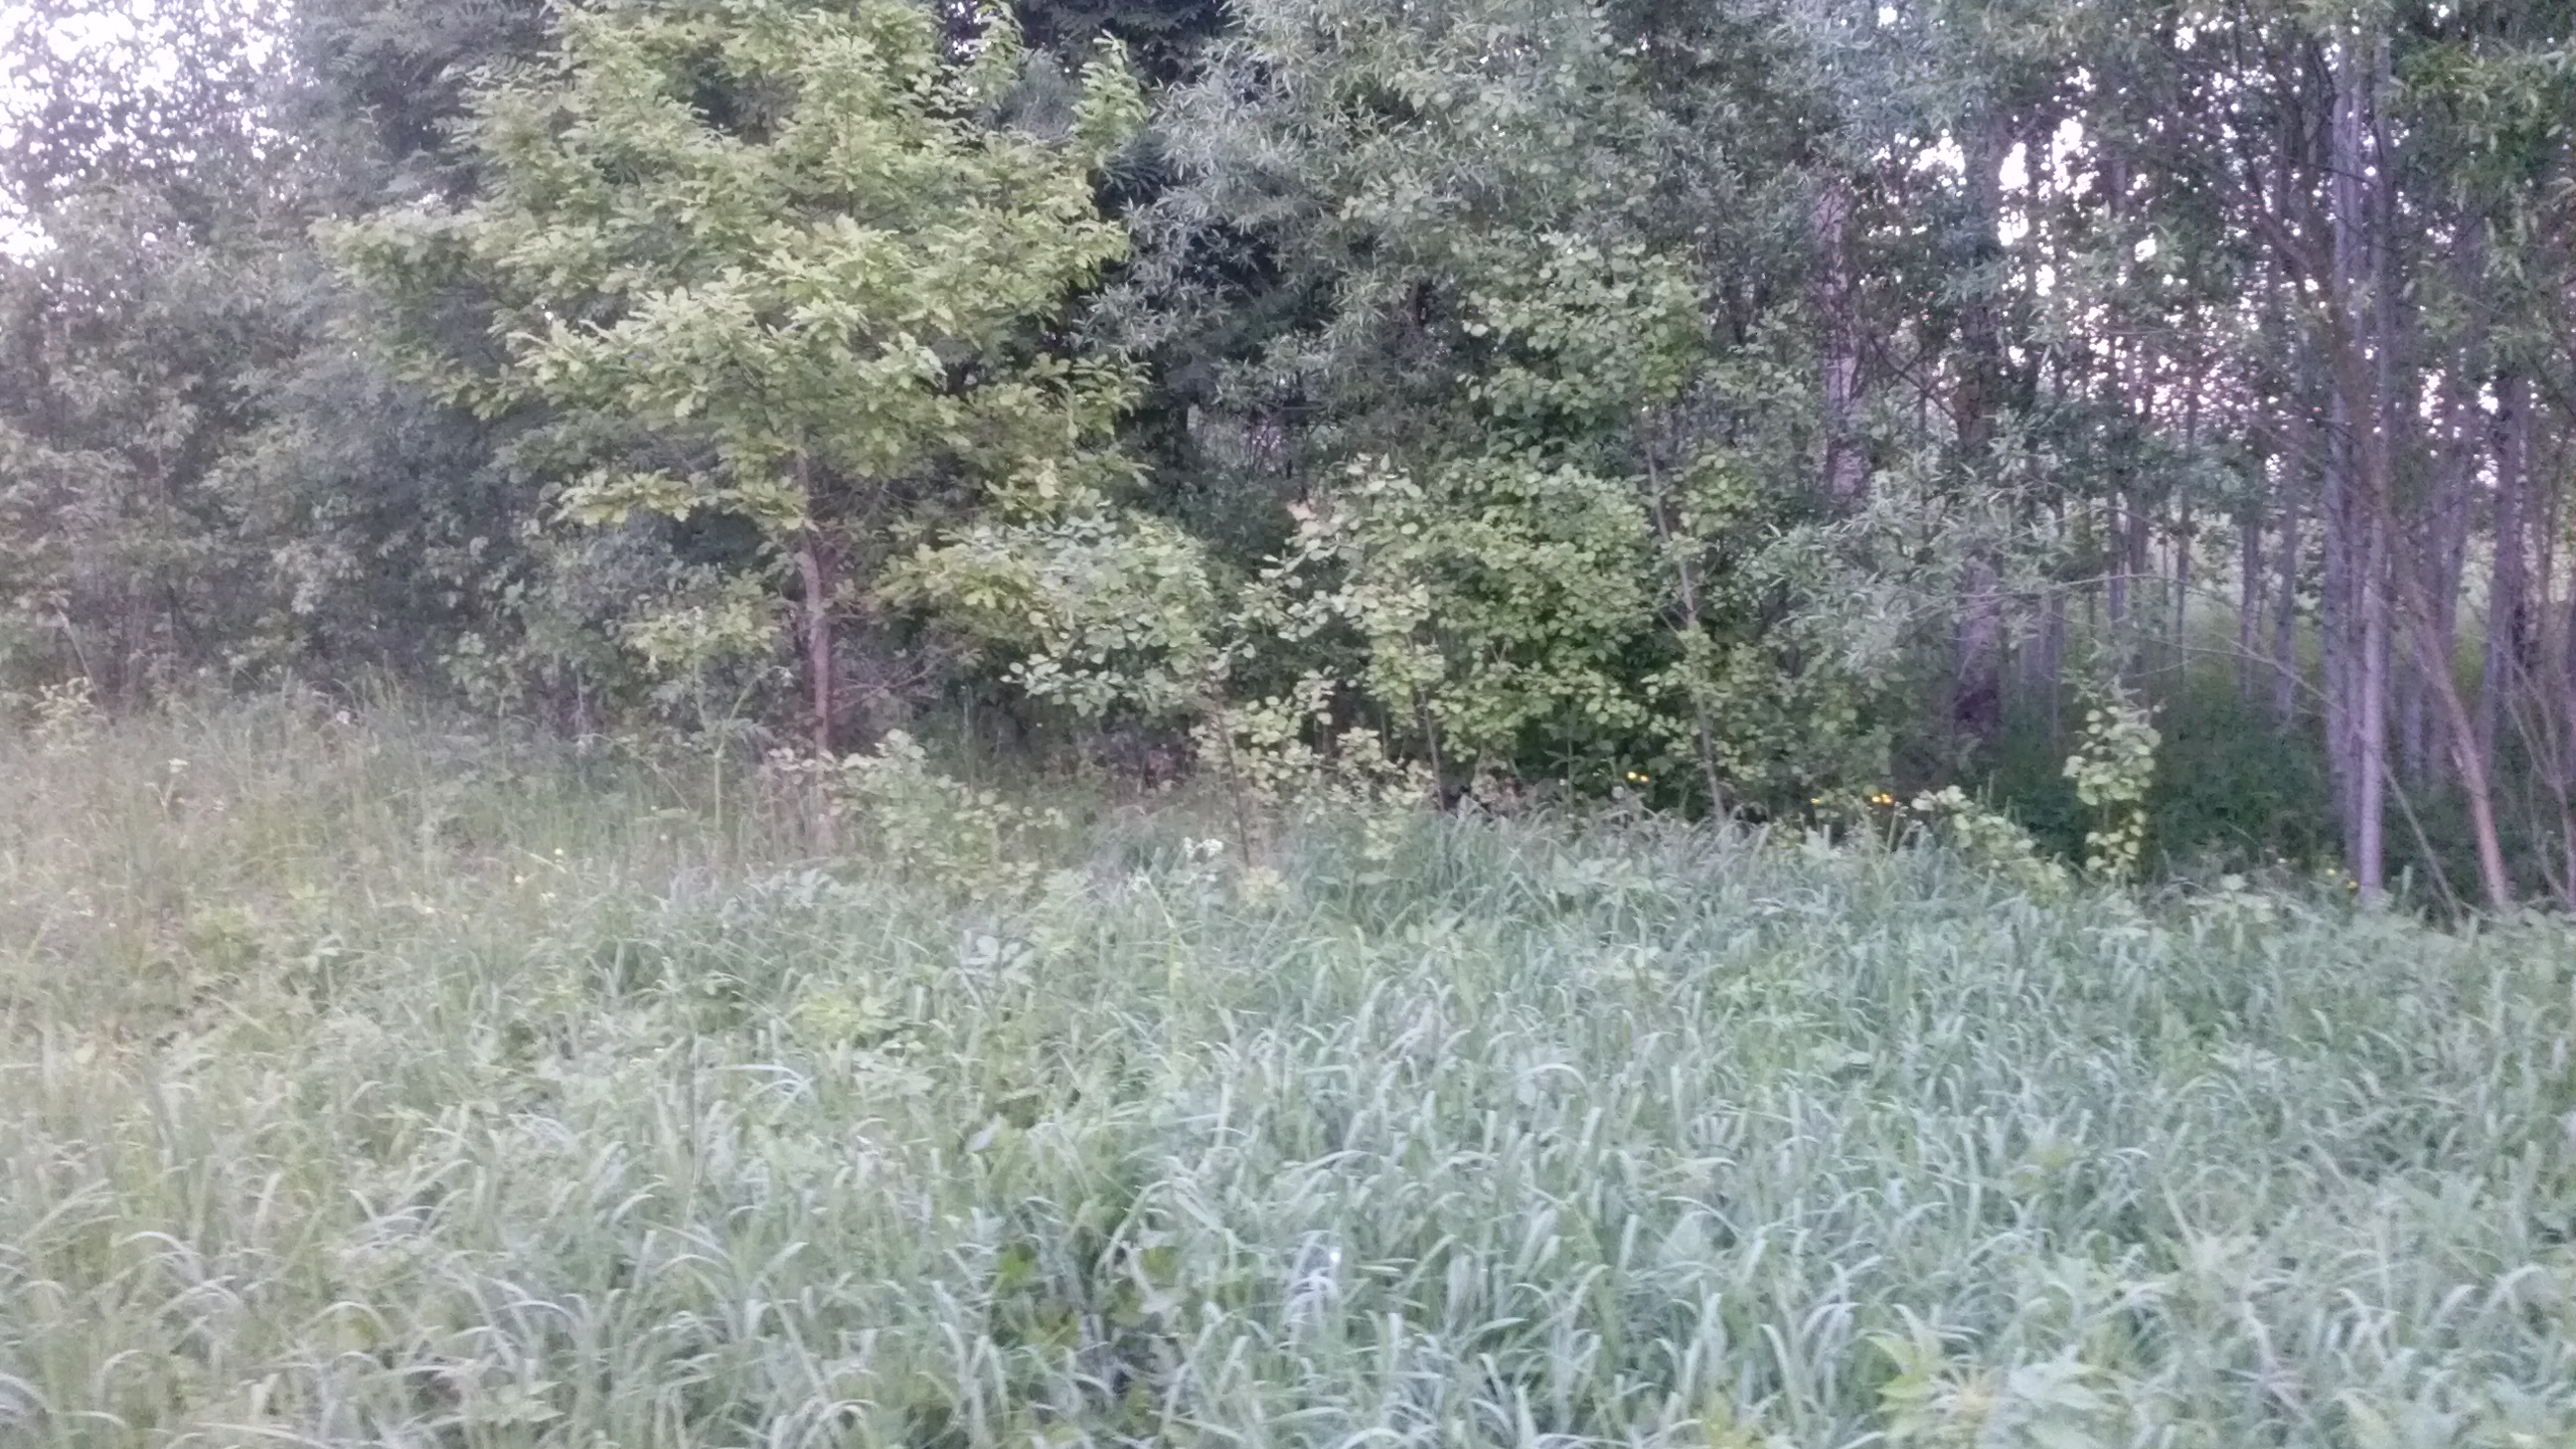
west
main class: Woodland
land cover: Broadleaved woodland
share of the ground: 25 - 50 %
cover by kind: herbaceous plants 50 %, broadleaved forest trees 40 %, shrubs 10 %
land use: Semi-natural and natural areas not in use
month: June
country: LV
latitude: 56.3825
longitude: 27.9619
